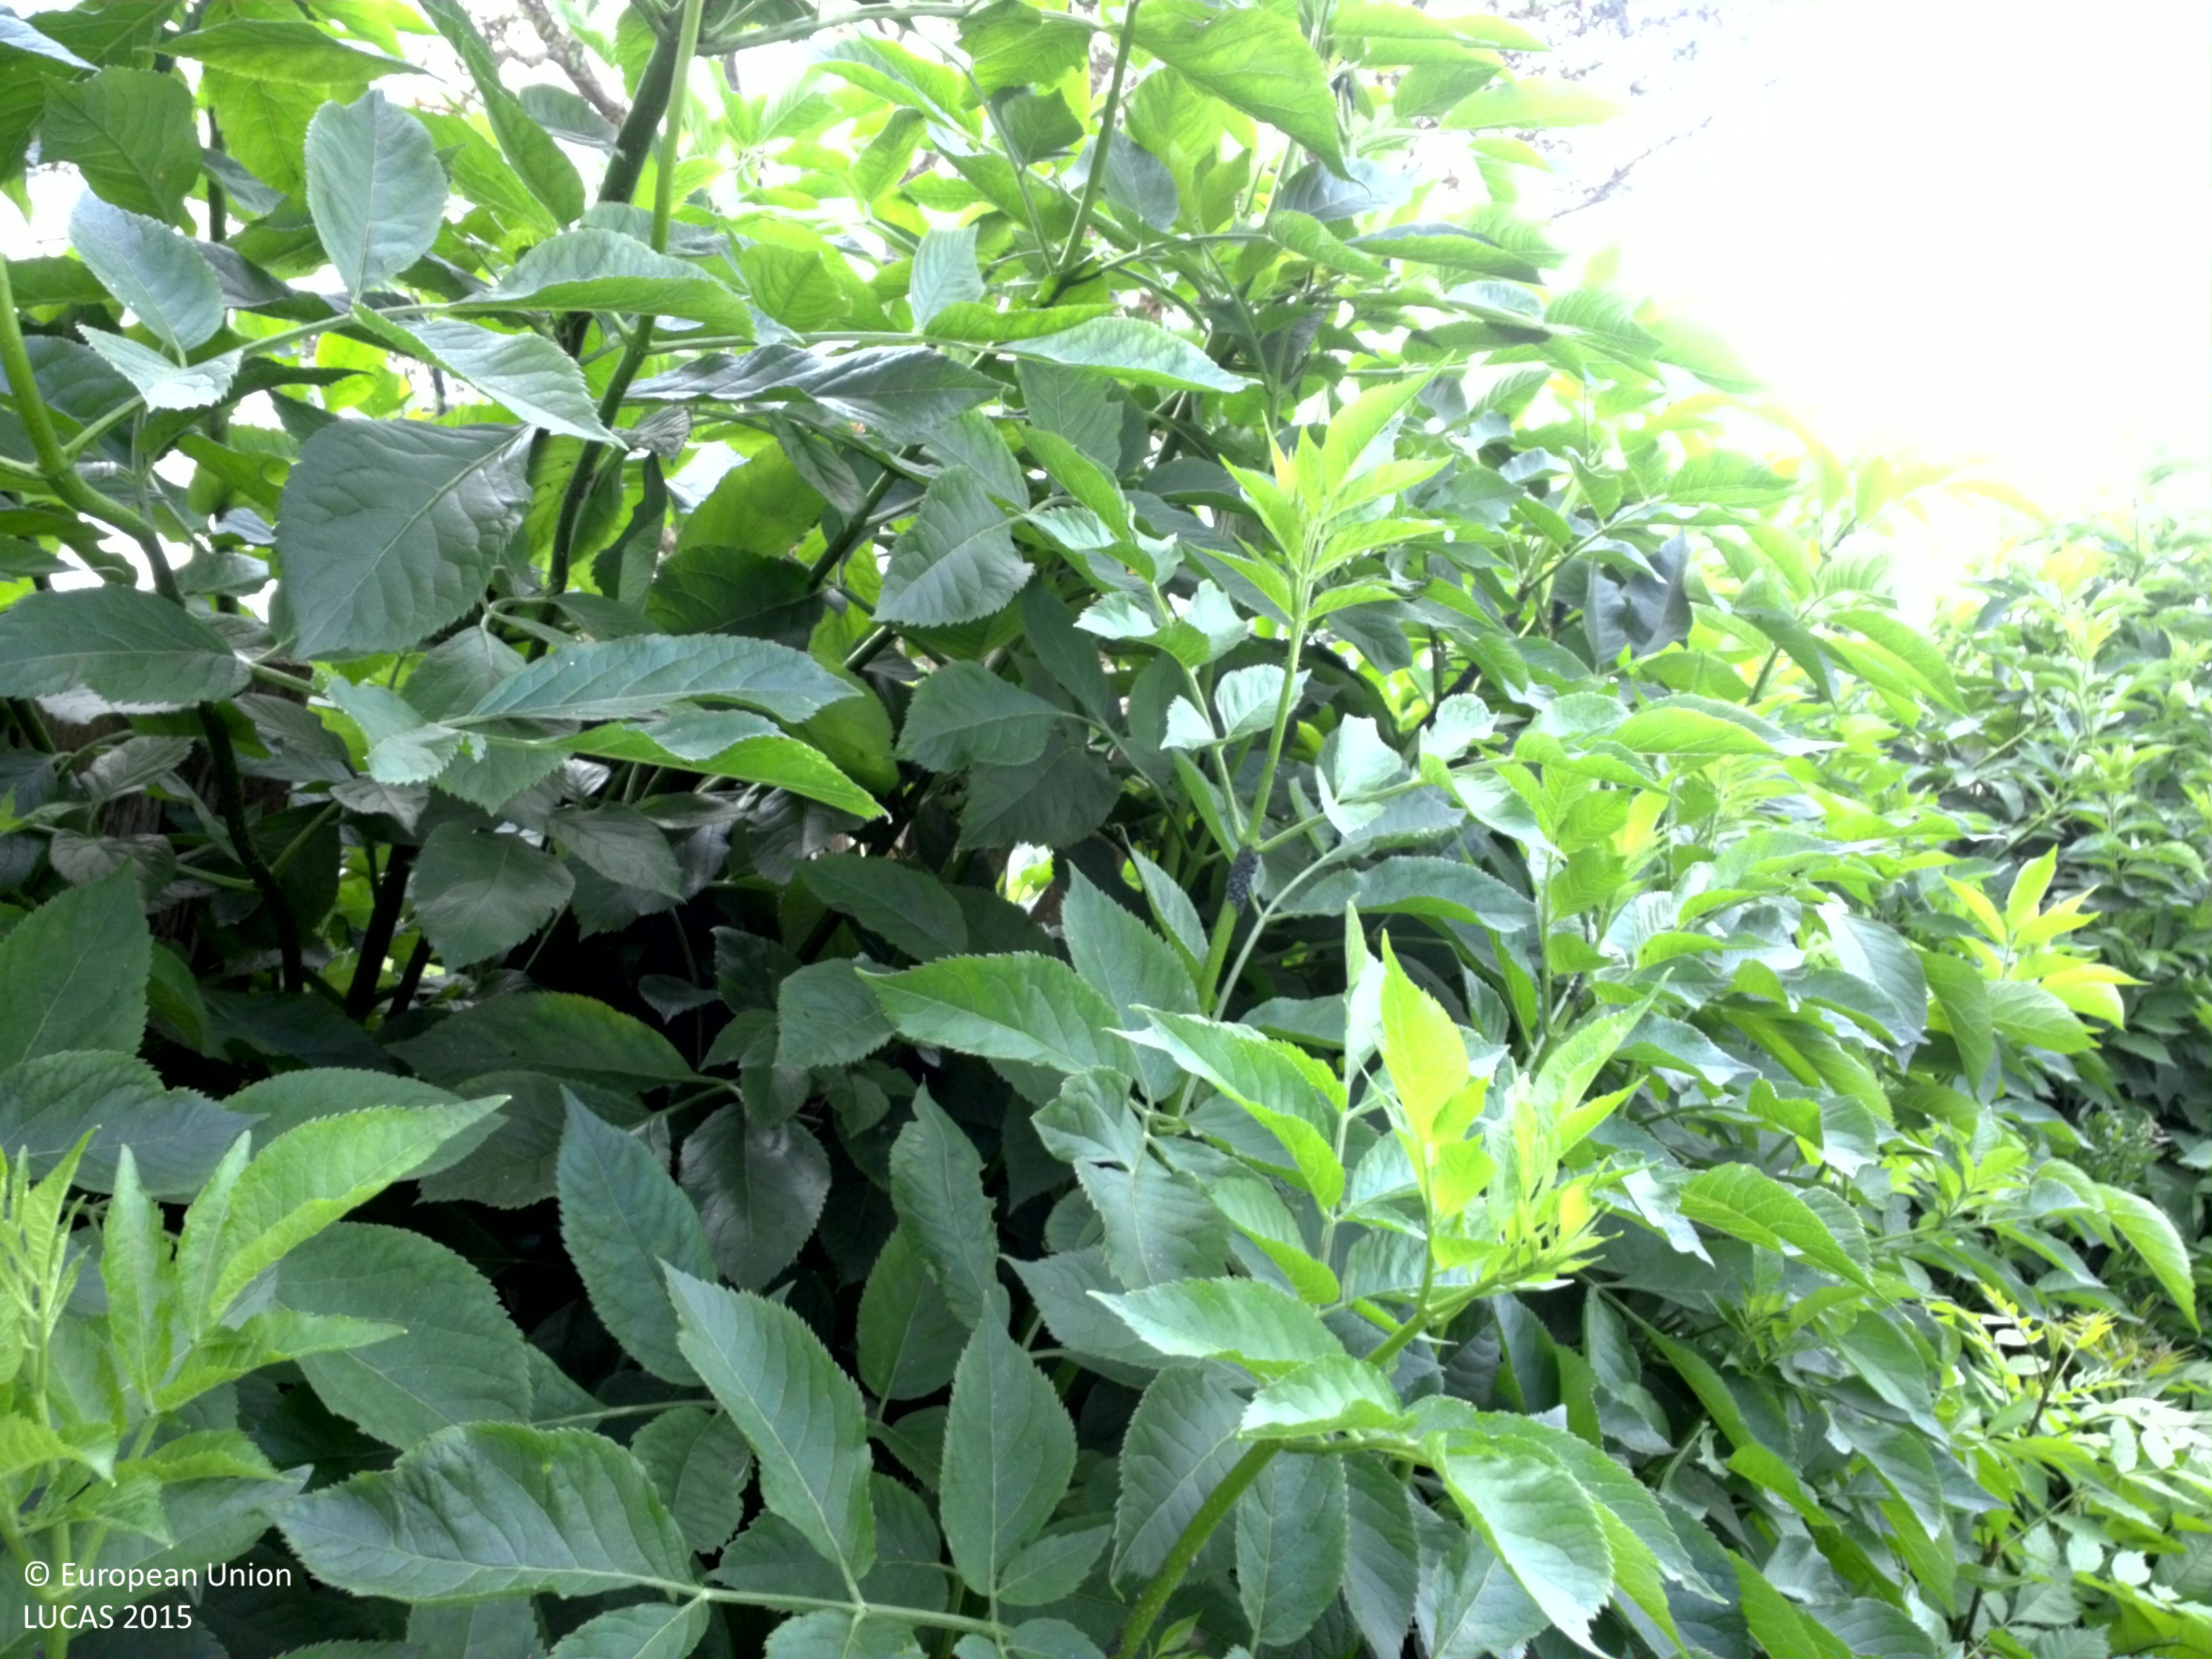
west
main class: Shrubland
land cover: Shrubland without tree cover
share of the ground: > 75 %
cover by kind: shrubs 100 %
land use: Residential
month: July
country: SE
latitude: 57.6044
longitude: 18.5266
